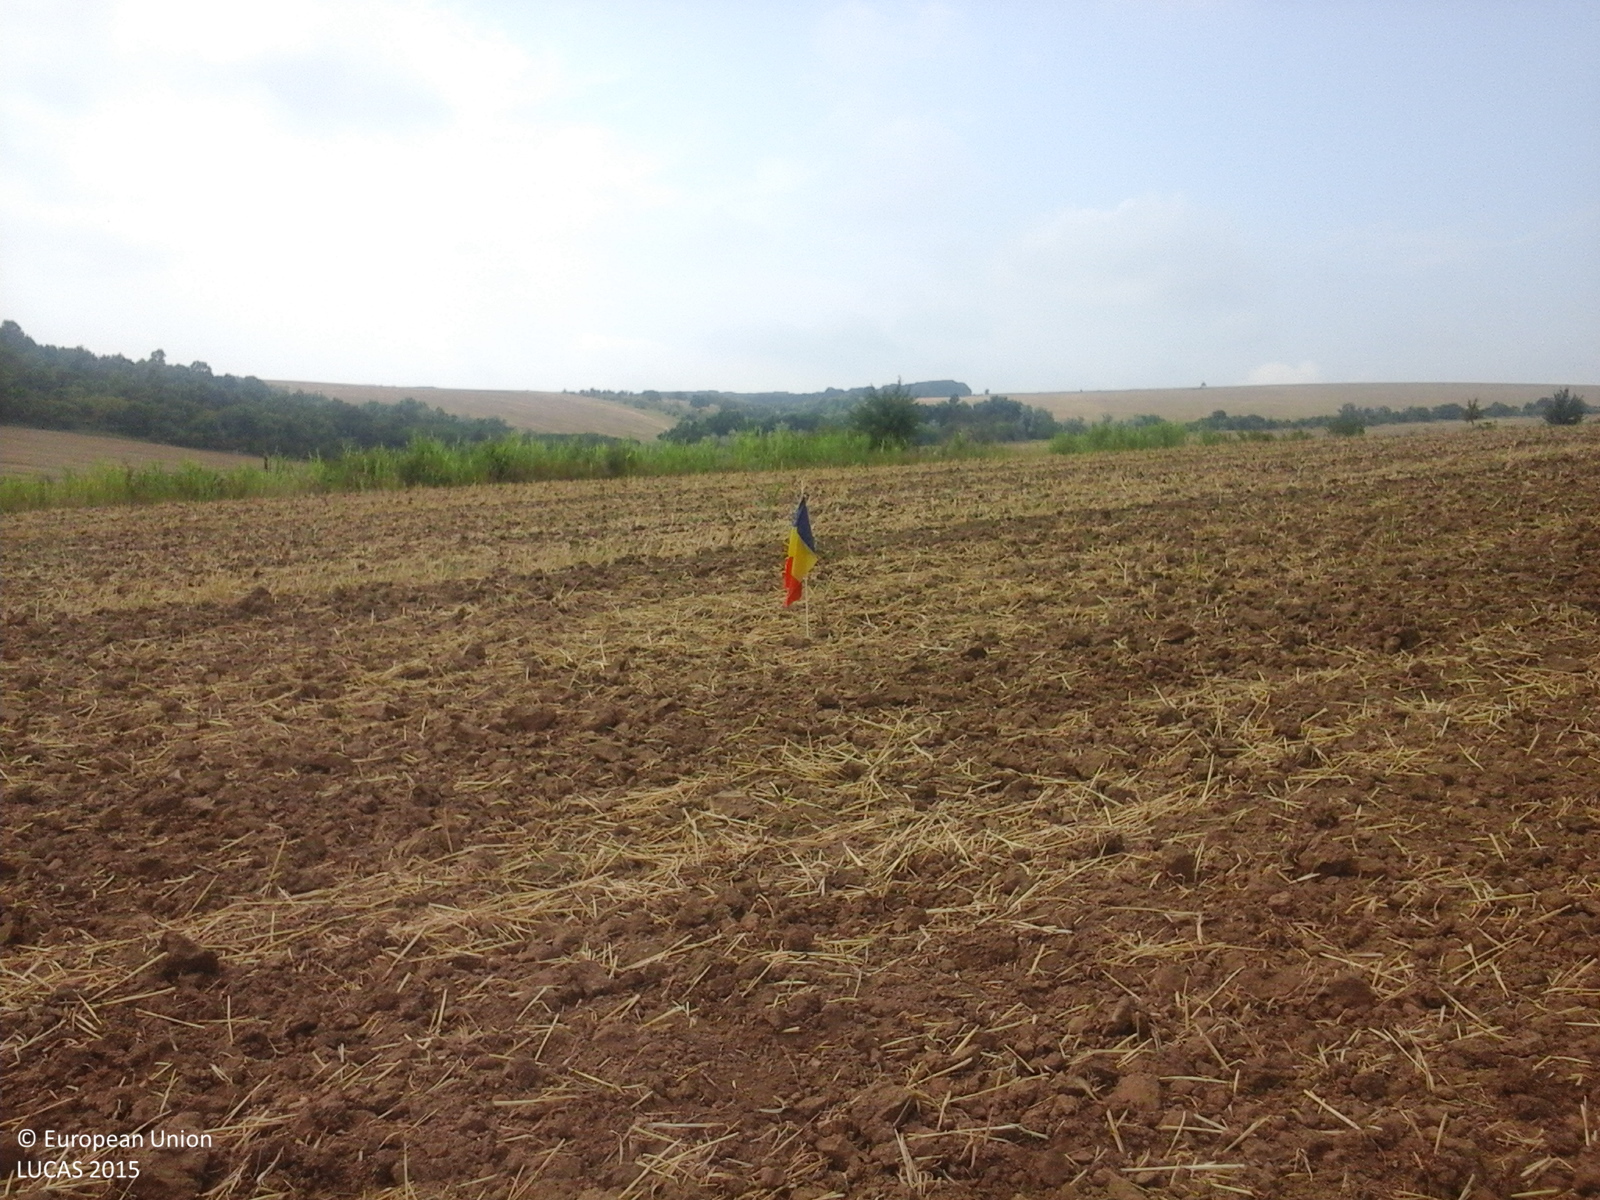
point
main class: Cropland
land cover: Durum wheat
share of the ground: < 10 %
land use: Agriculture (excluding fallow land and kitchen gardens)
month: July
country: RO
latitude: 44.9857
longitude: 28.4537
